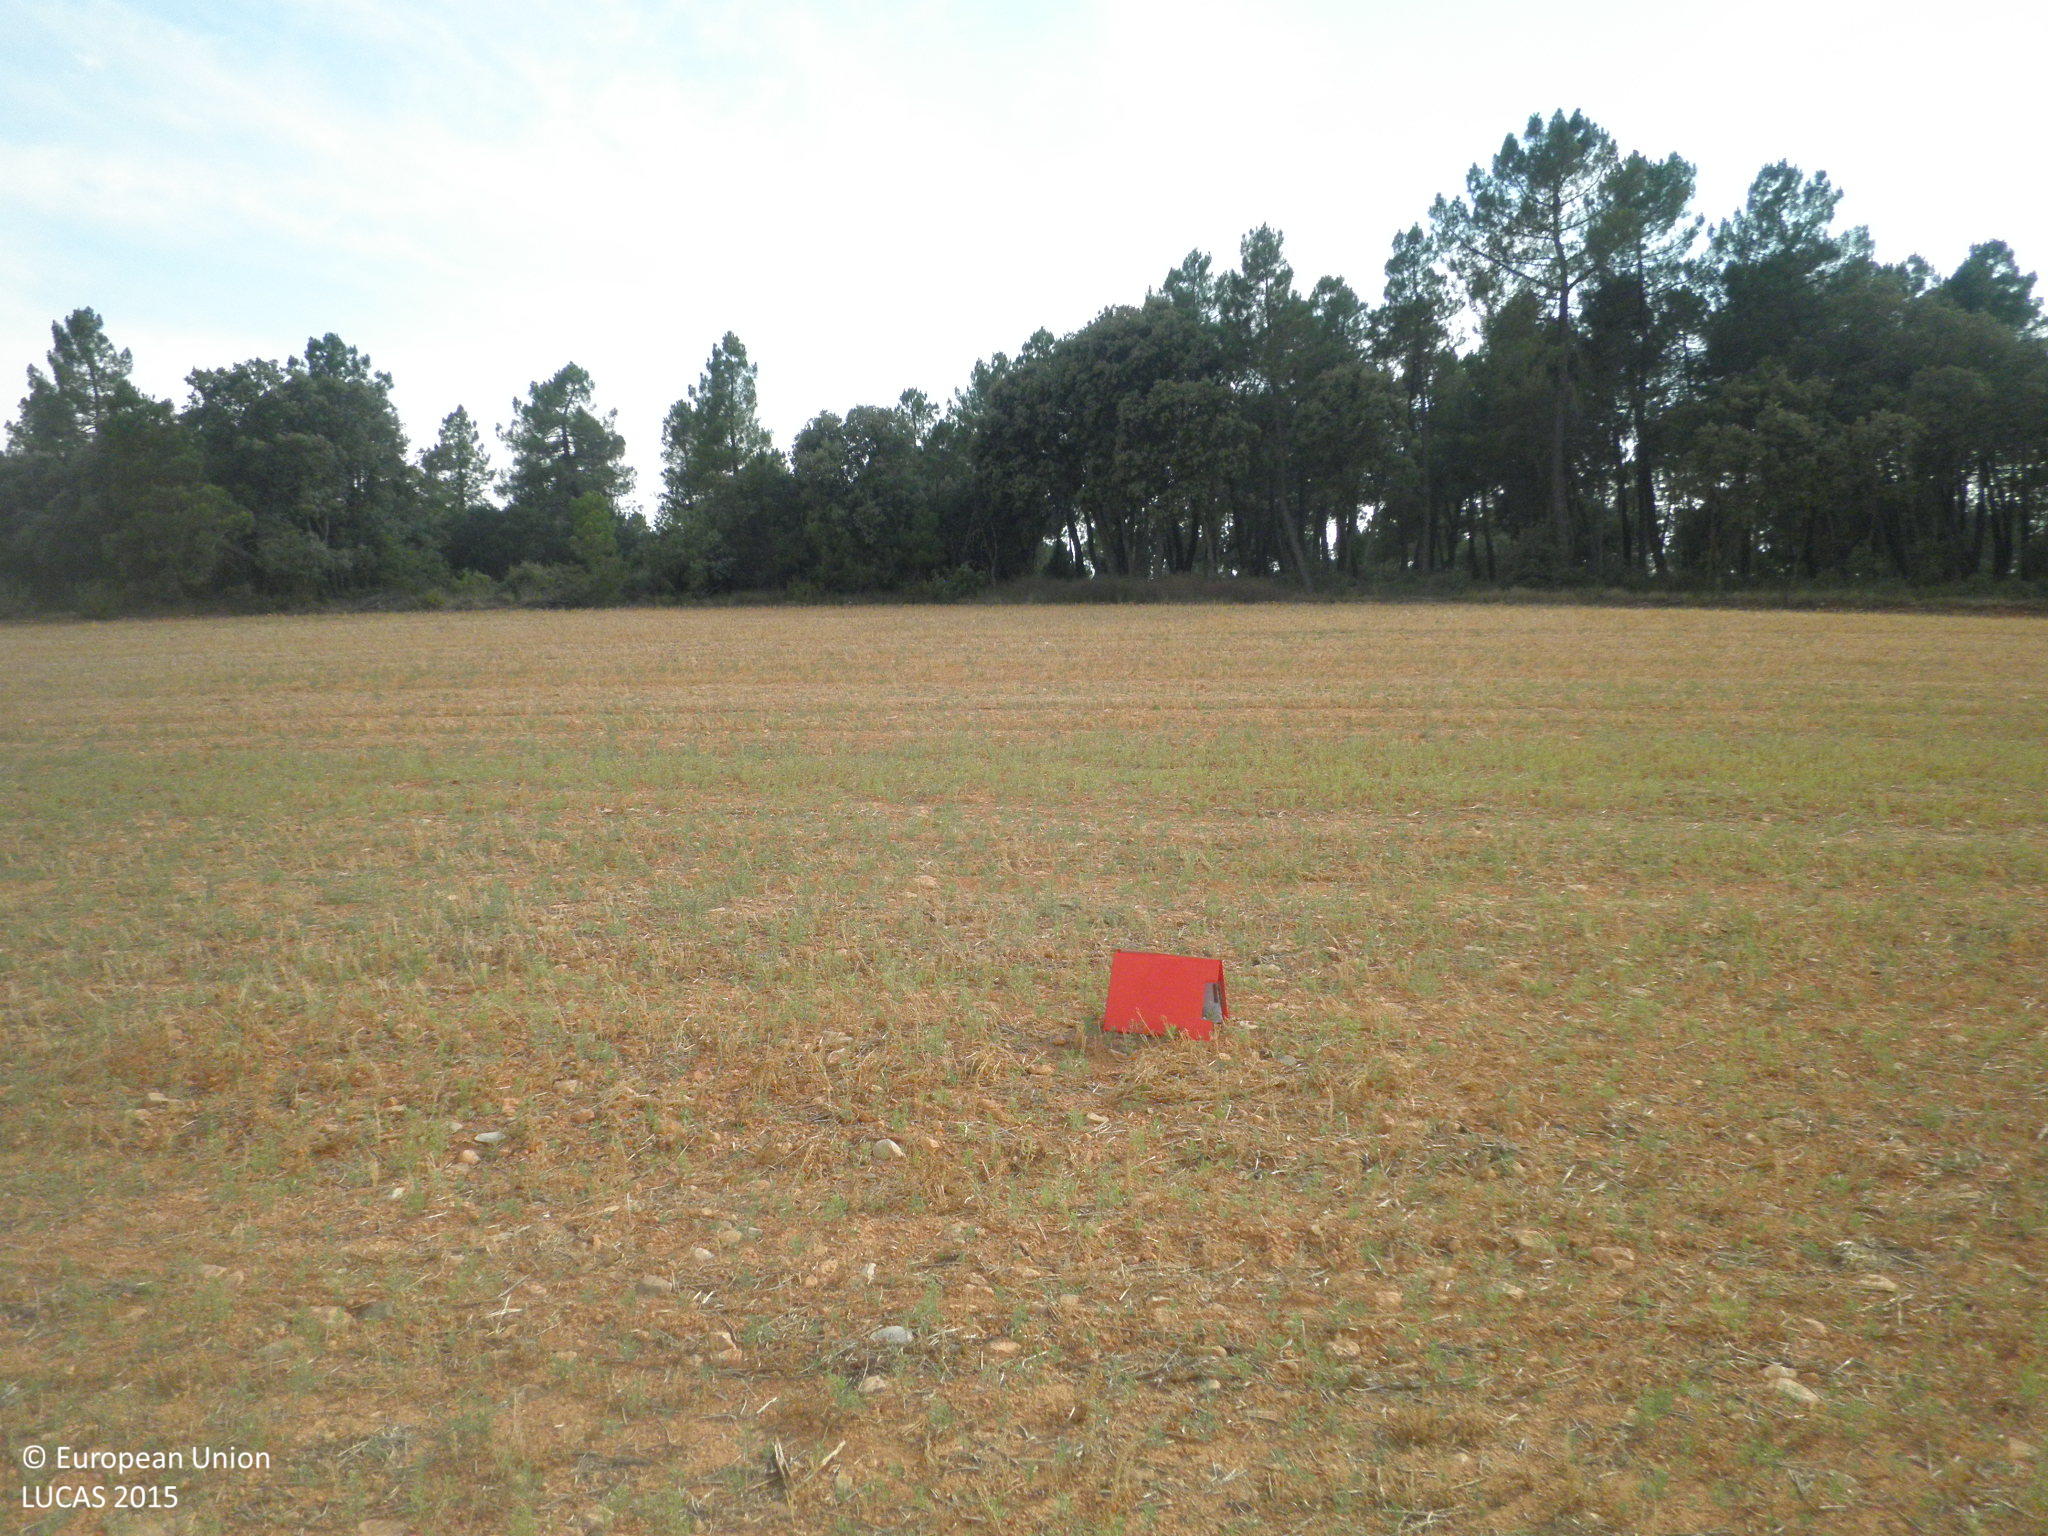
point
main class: Cropland
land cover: Dry pulses
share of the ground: < 10 %
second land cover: Spontaneously vegetated surfaces
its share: 10 - 25 %
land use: Agriculture (excluding fallow land and kitchen gardens)
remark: Harvested field
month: July
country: ES
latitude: 39.6028
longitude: -1.6876
